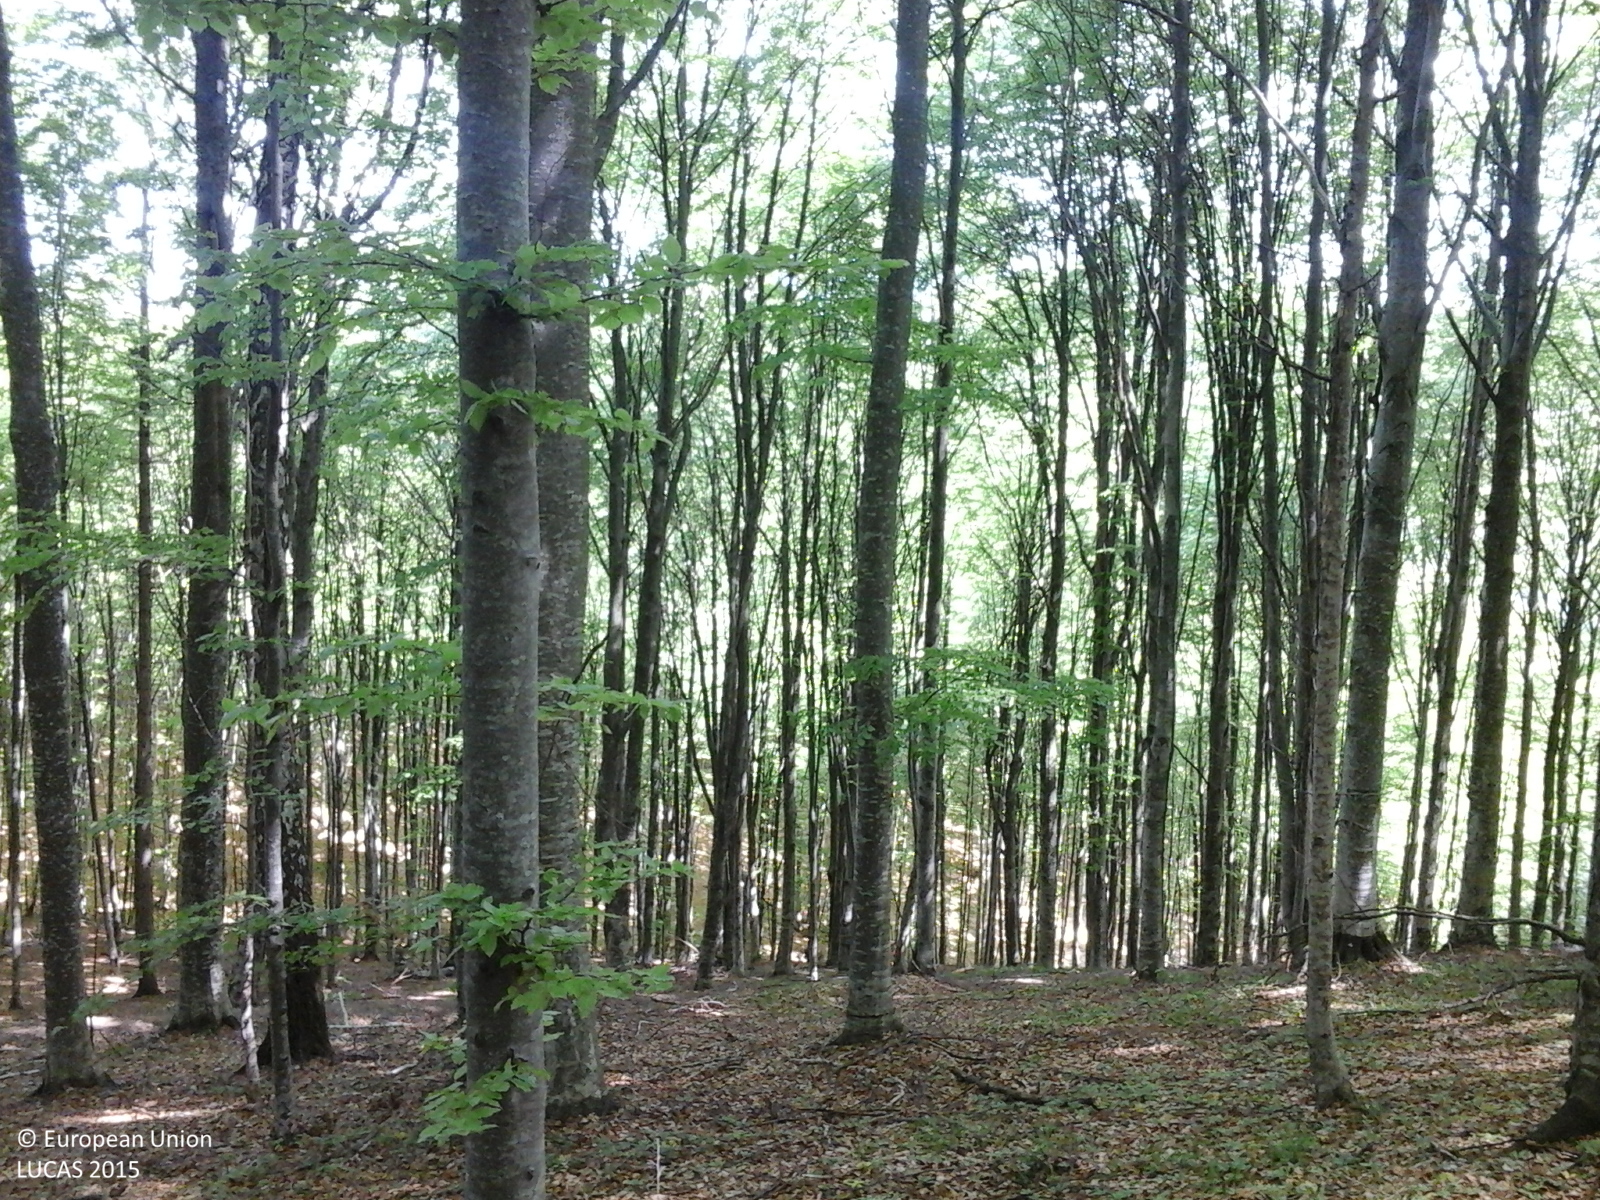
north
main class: Woodland
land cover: Broadleaved woodland
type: beech forest
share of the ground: > 75 %
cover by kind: broadleaved forest trees 100 %
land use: Forestry
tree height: > 5 m
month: May
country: RO
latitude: 45.7266
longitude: 25.9832
